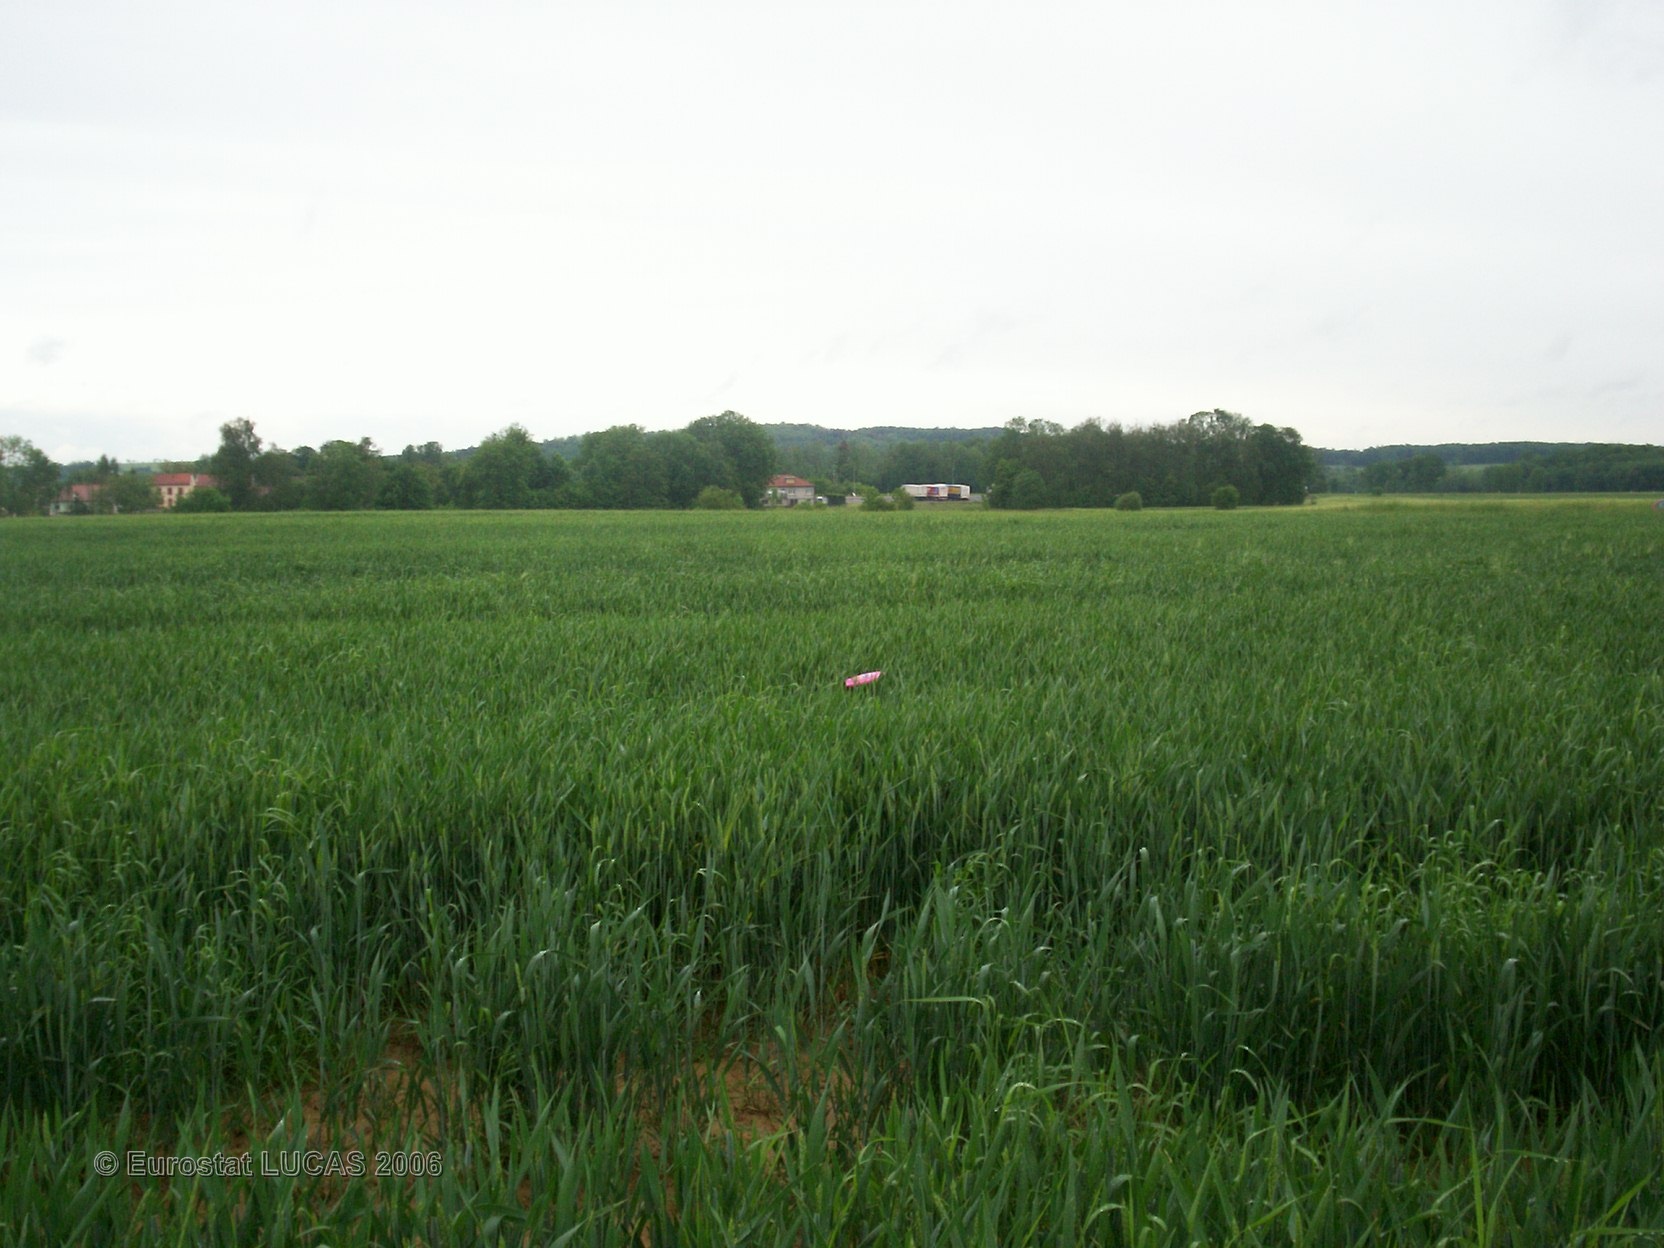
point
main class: Cropland
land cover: Common wheat
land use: Agriculture (excluding fallow land and kitchen gardens)
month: May
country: FR
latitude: 48.5542
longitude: 6.7626
